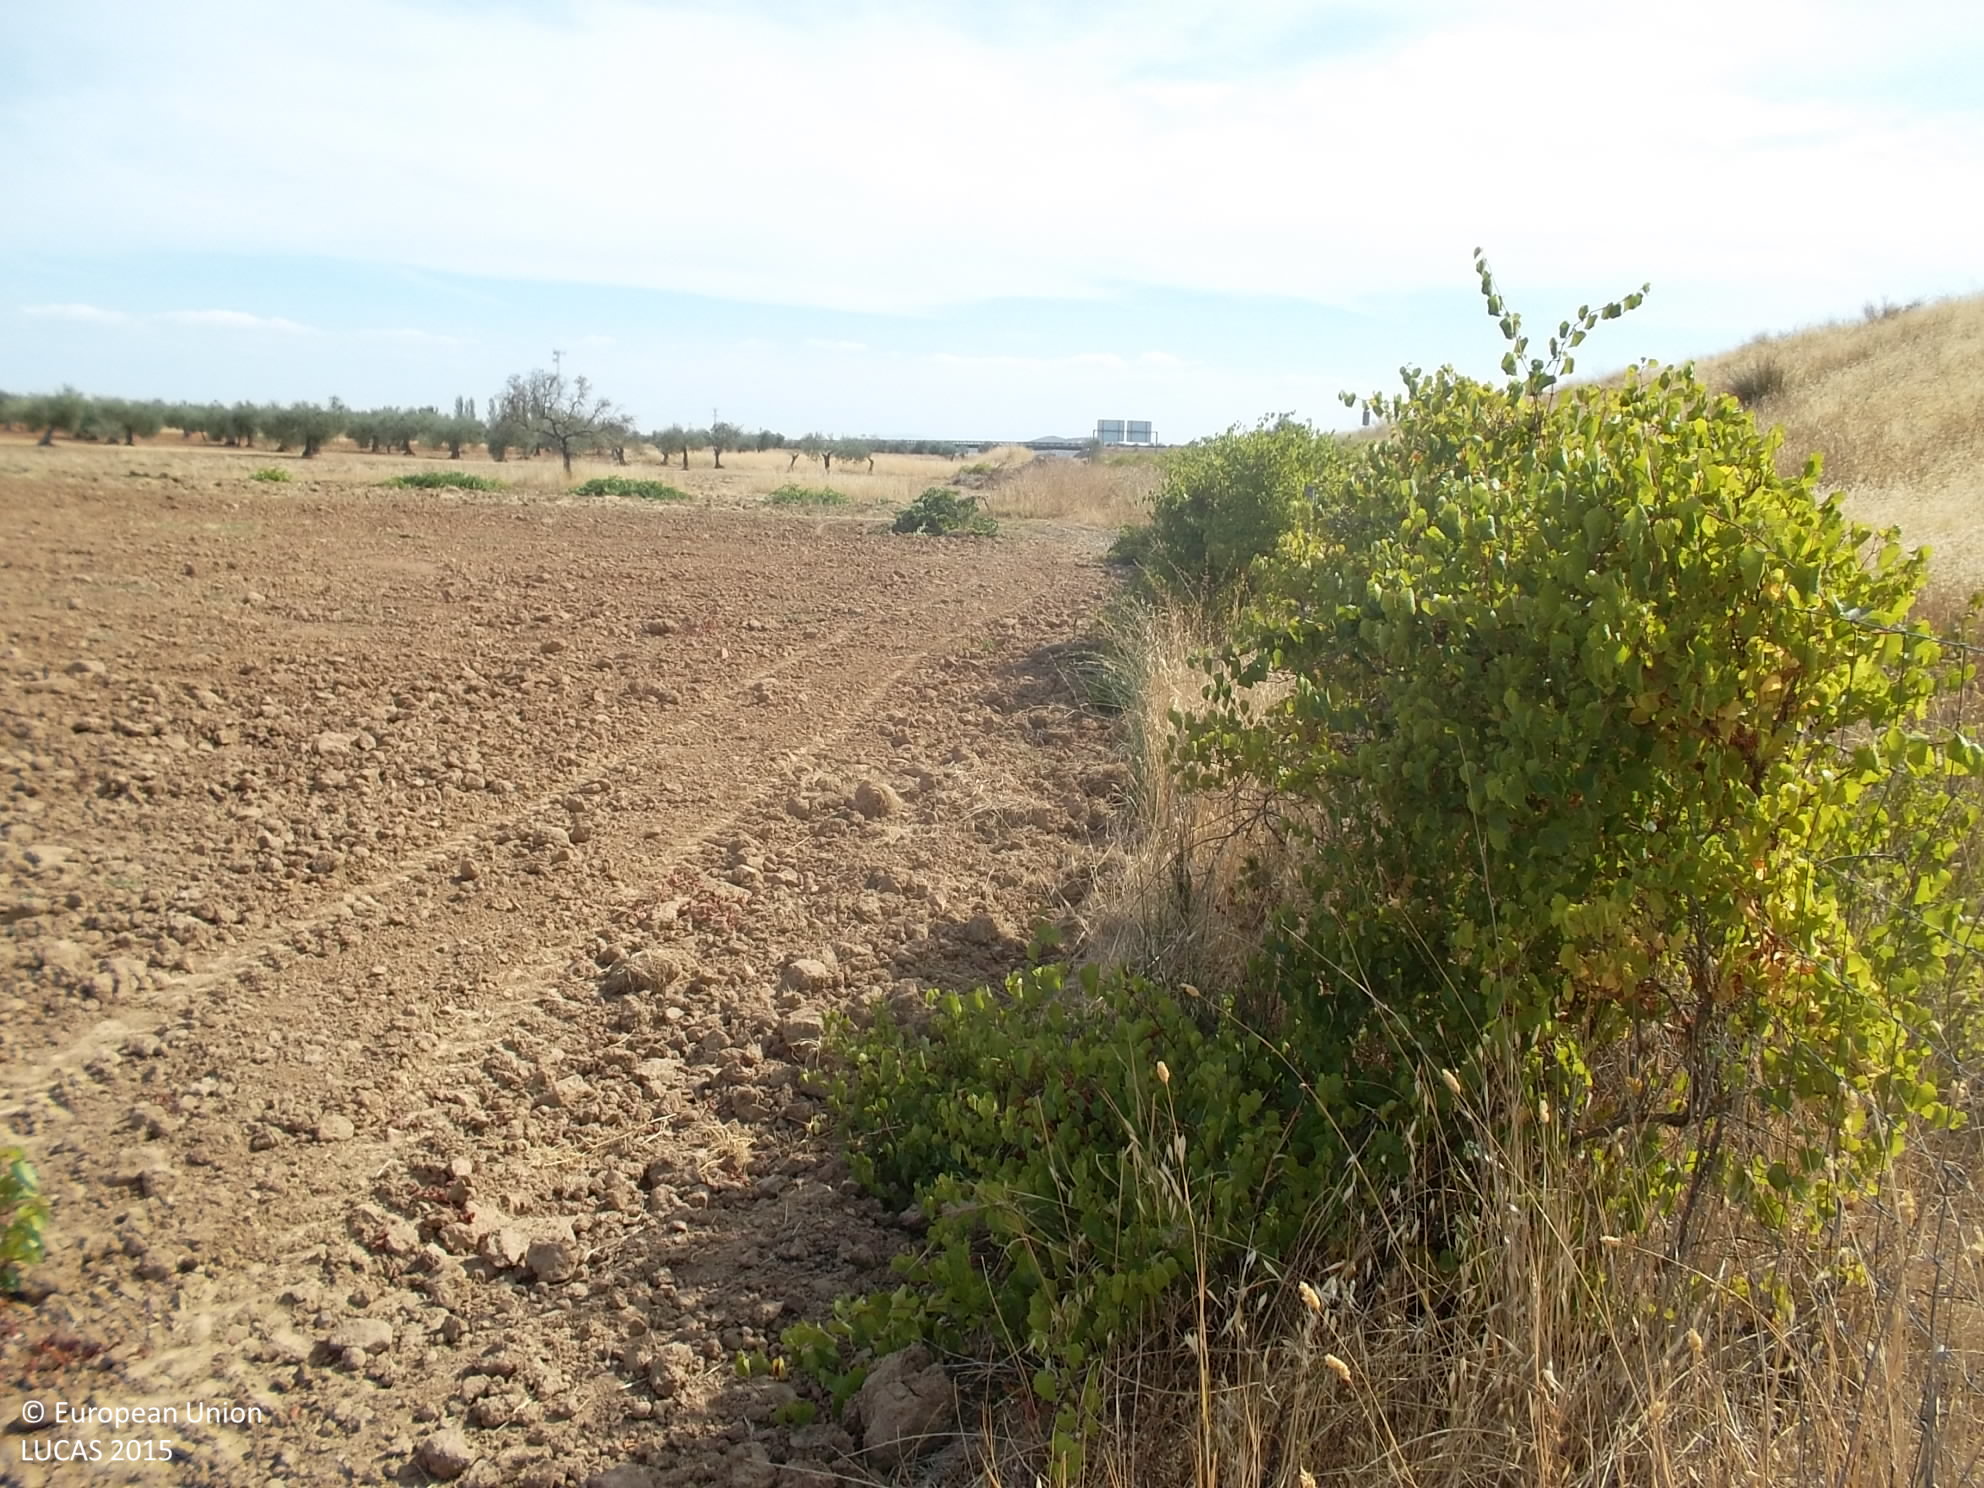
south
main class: Grassland
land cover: Grassland without tree/shrub cover
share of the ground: > 75 %
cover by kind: herbaceous plants 100 %
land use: Road transport
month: September
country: ES
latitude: 38.3895
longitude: -6.3400
